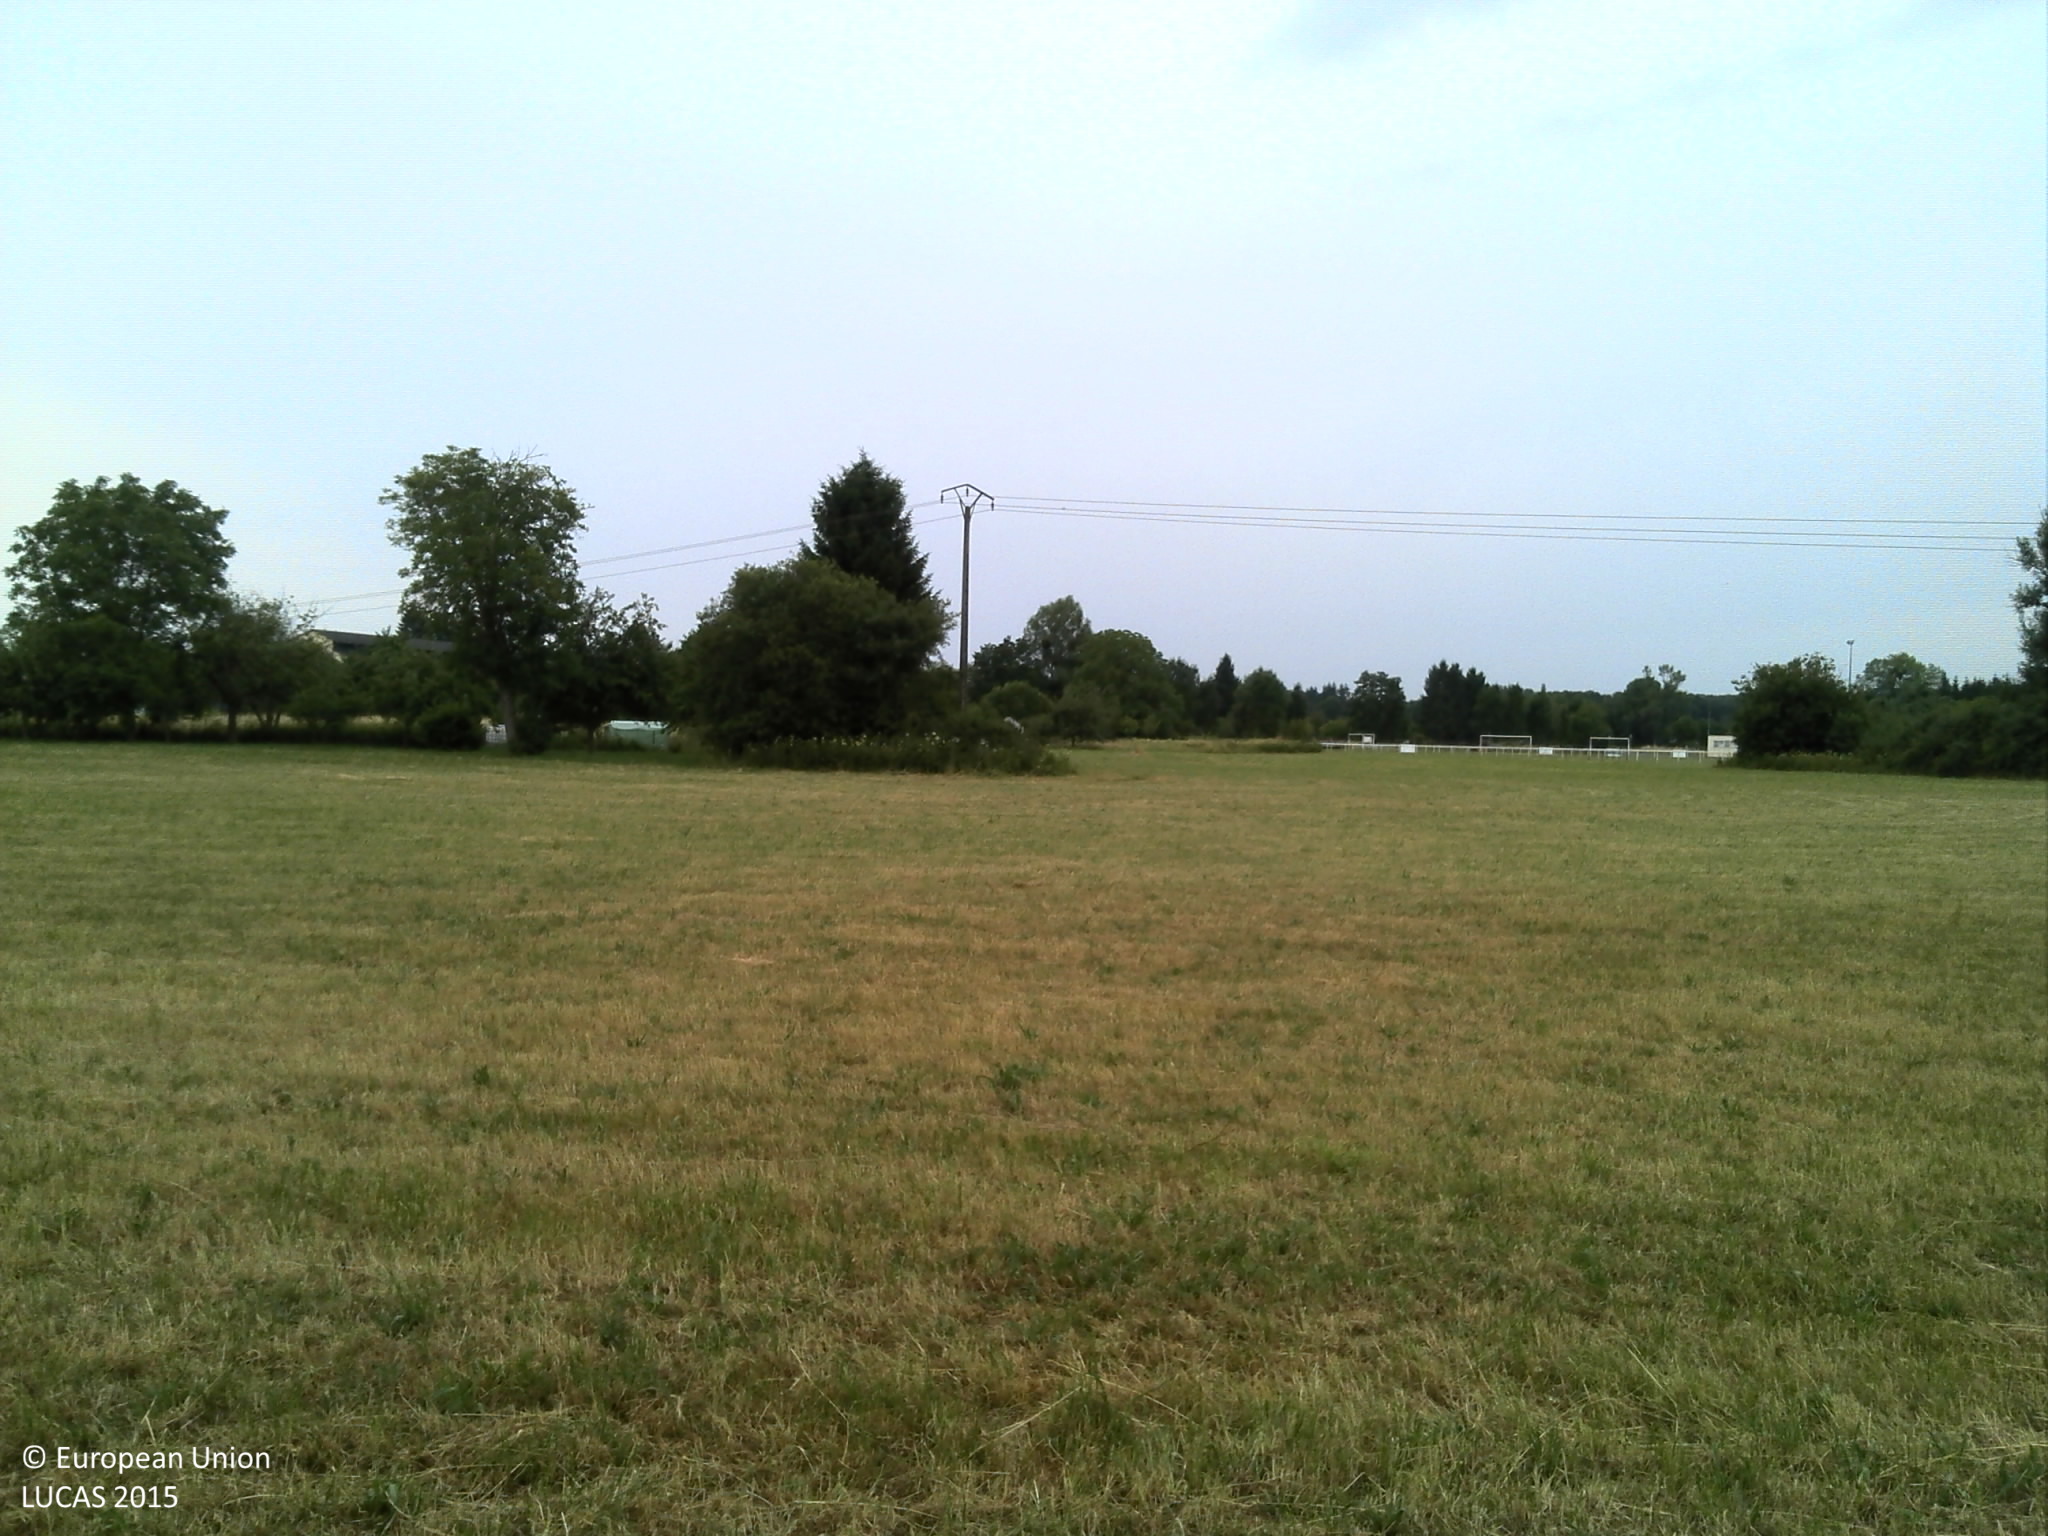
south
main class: Grassland
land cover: Grassland without tree/shrub cover
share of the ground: > 75 %
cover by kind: herbaceous plants 100 %
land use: Agriculture (excluding fallow land and kitchen gardens)
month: July
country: FR
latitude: 49.7717
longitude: 4.6785
